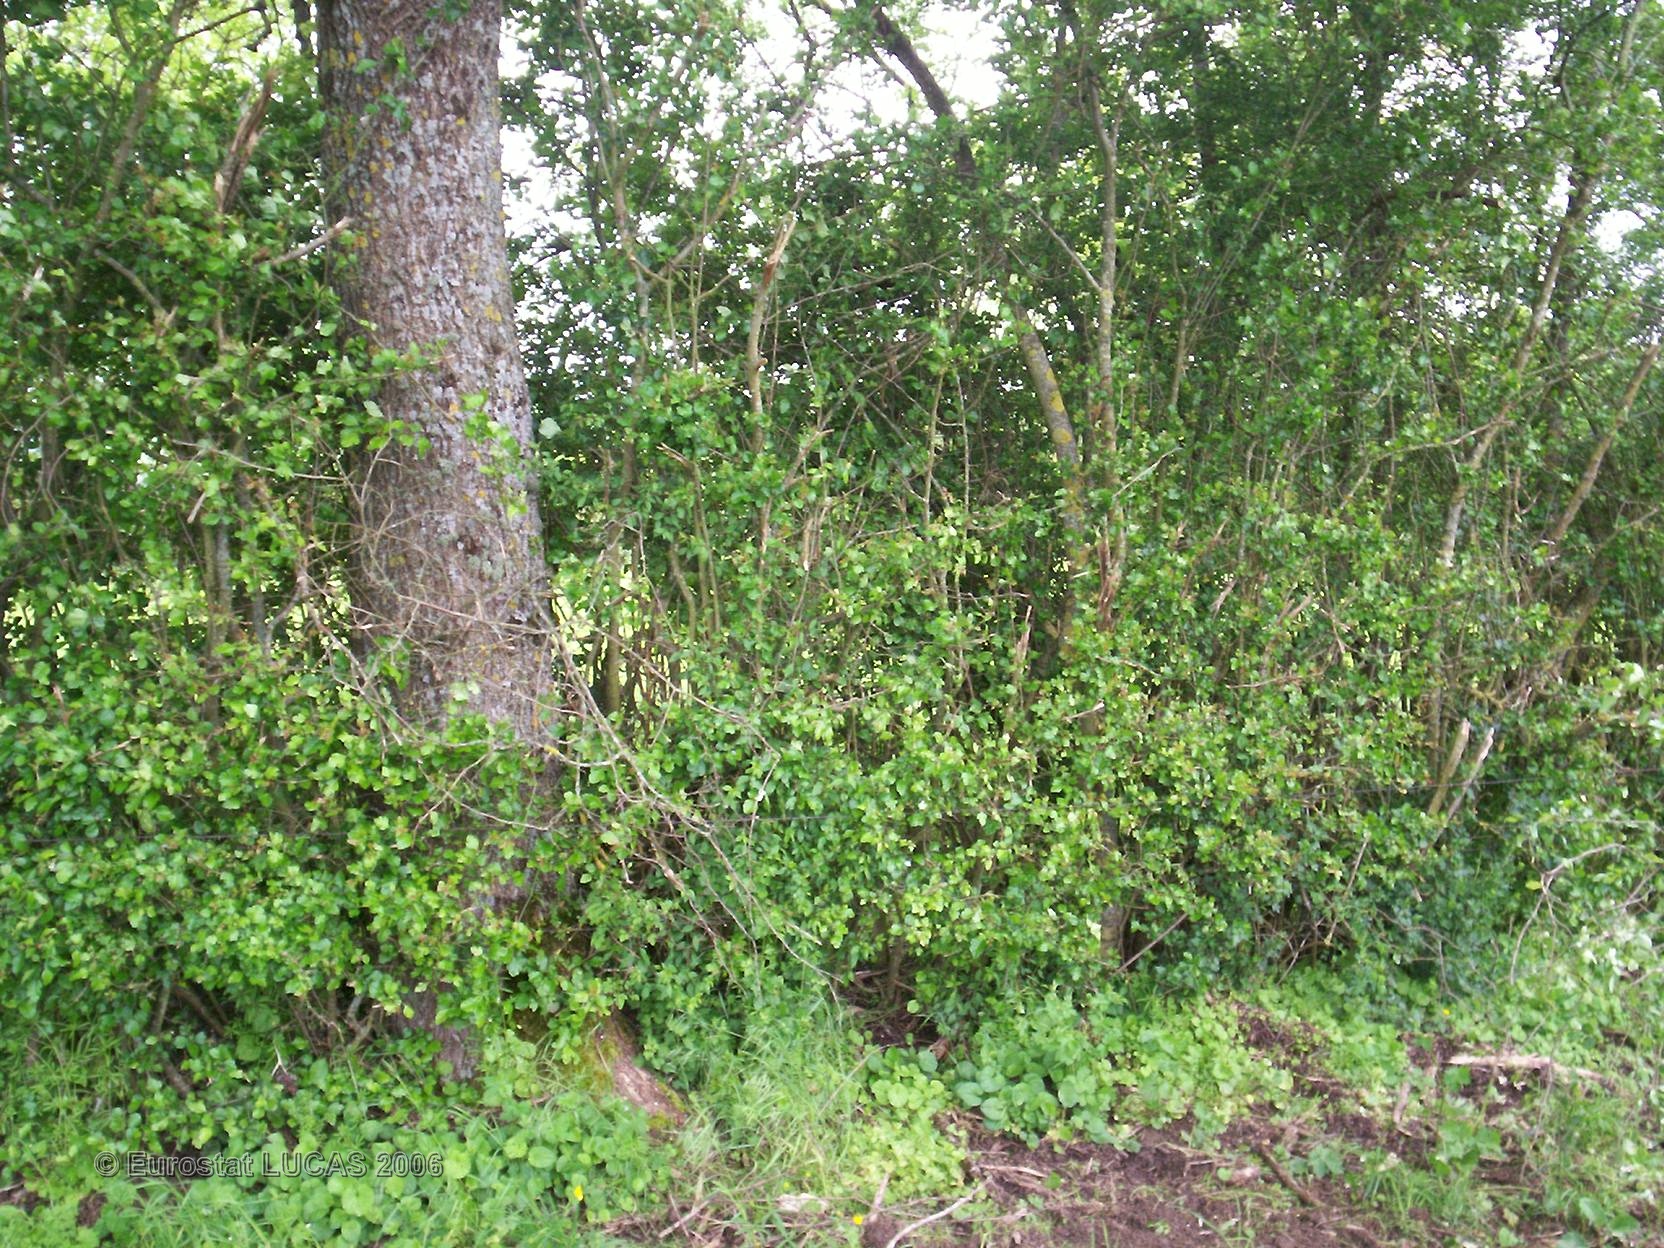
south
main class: Grassland
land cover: Grassland without tree/shrub cover
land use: Agriculture (excluding fallow land and kitchen gardens)
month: May
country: FR
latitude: 47.1189
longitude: 4.6358
